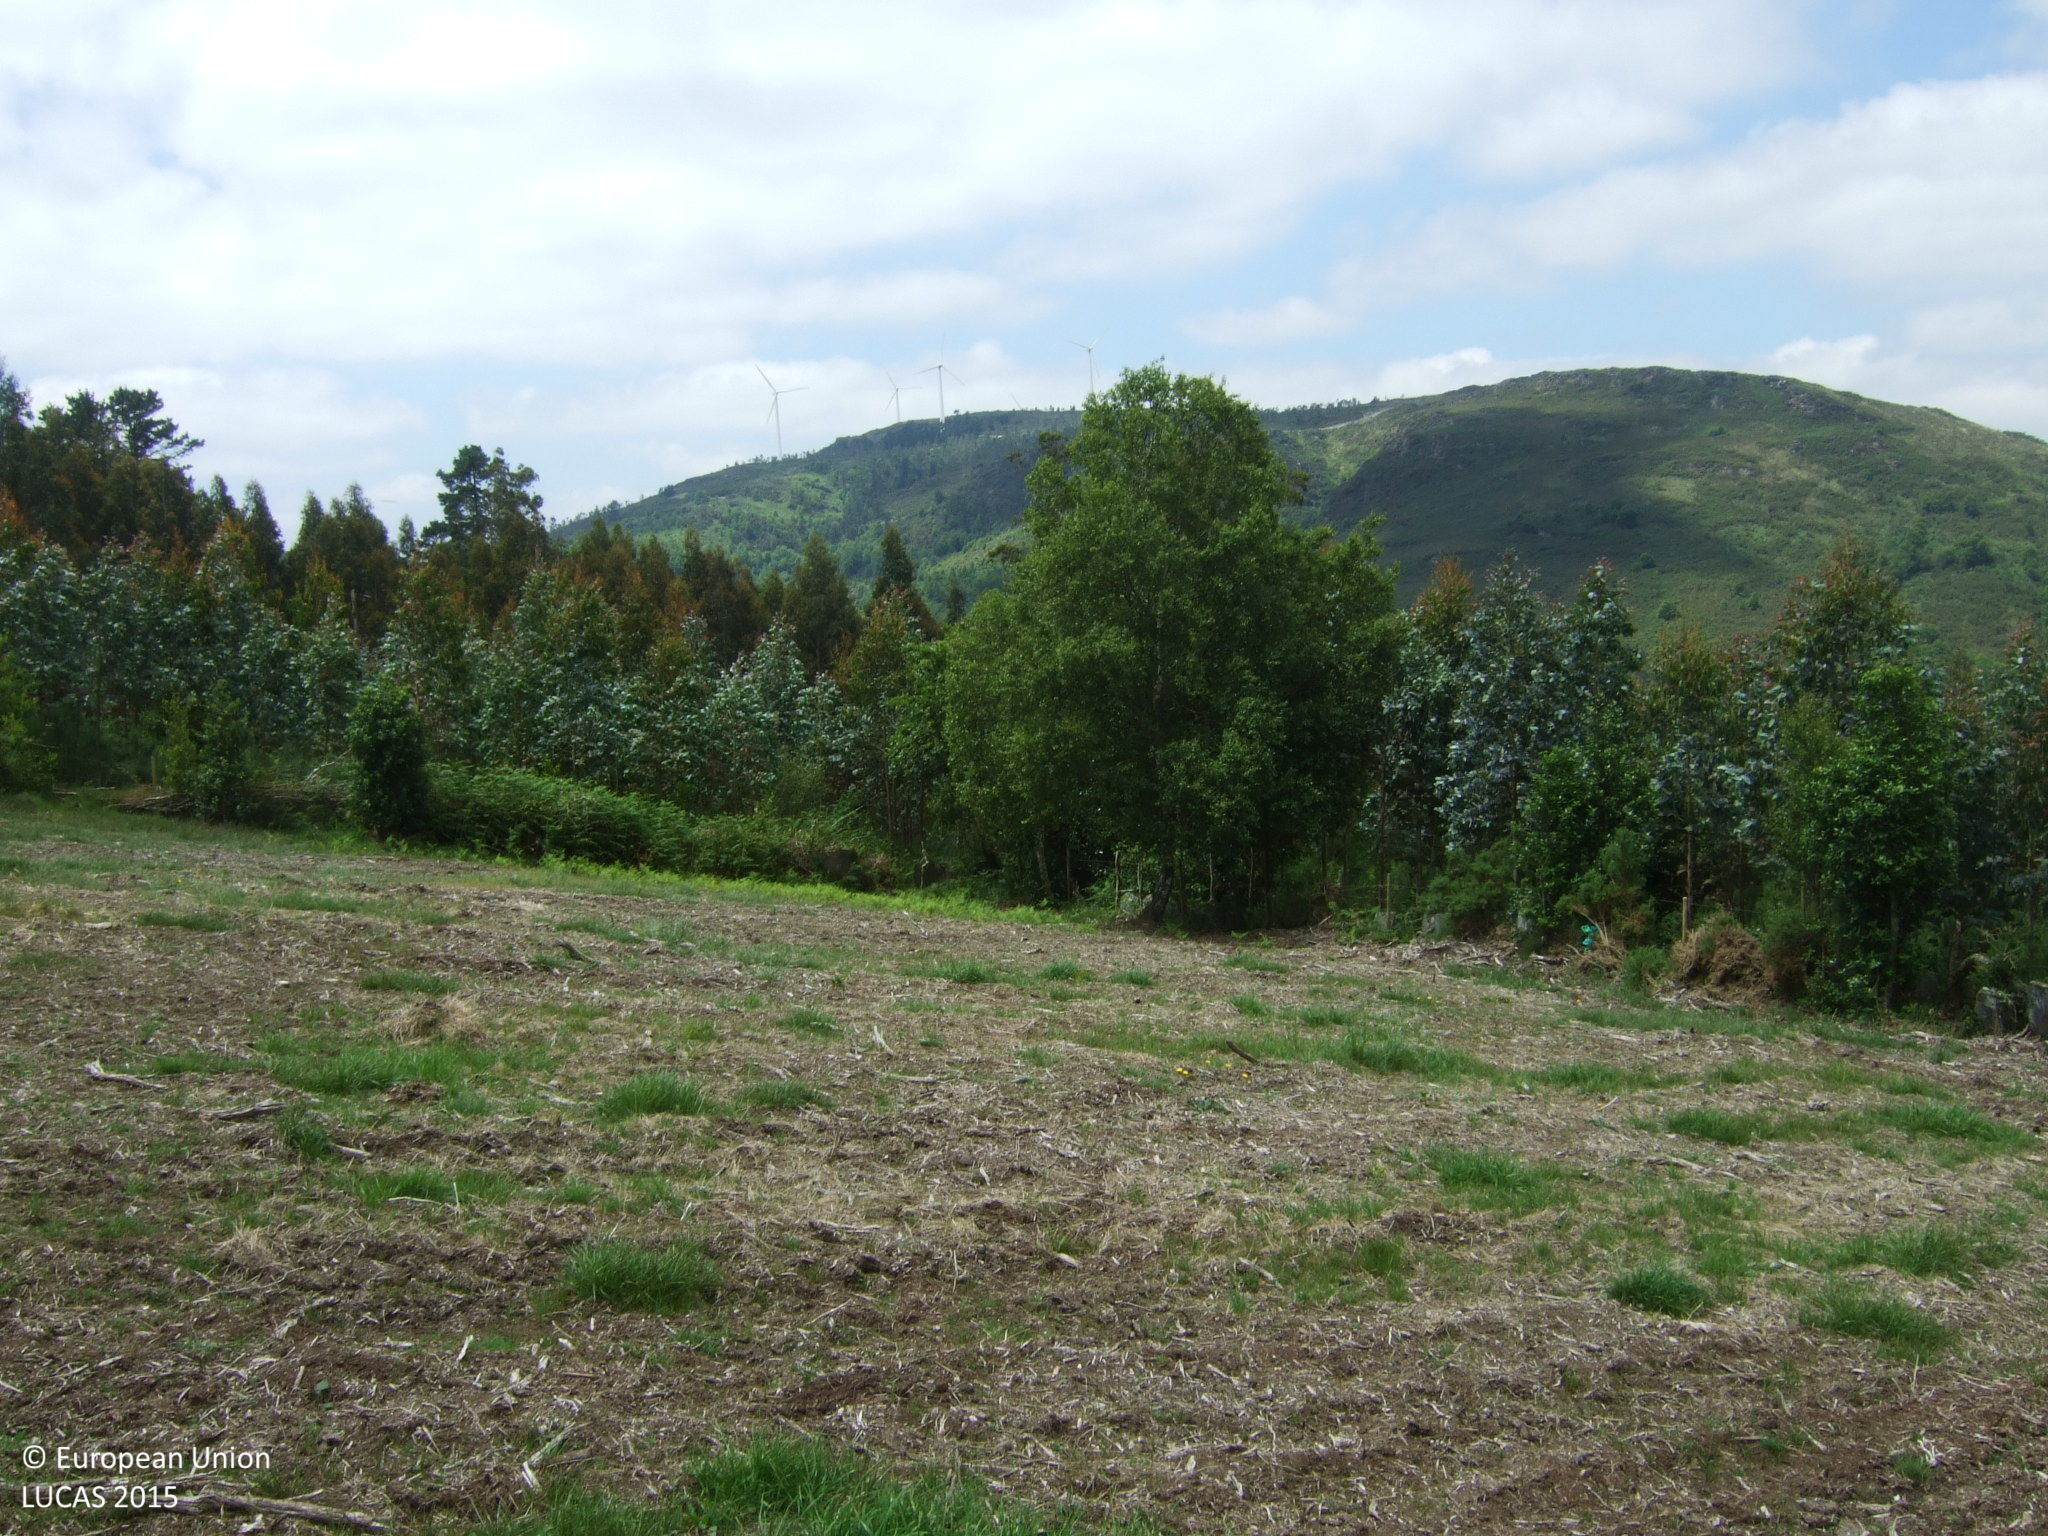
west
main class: Shrubland
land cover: Shrubland with sparse tree cover
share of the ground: > 75 %
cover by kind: shrubs 95 %, broadleaved forest trees 5 %
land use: Semi-natural and natural areas not in use
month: June
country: ES
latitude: 43.5298
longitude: -7.8225
